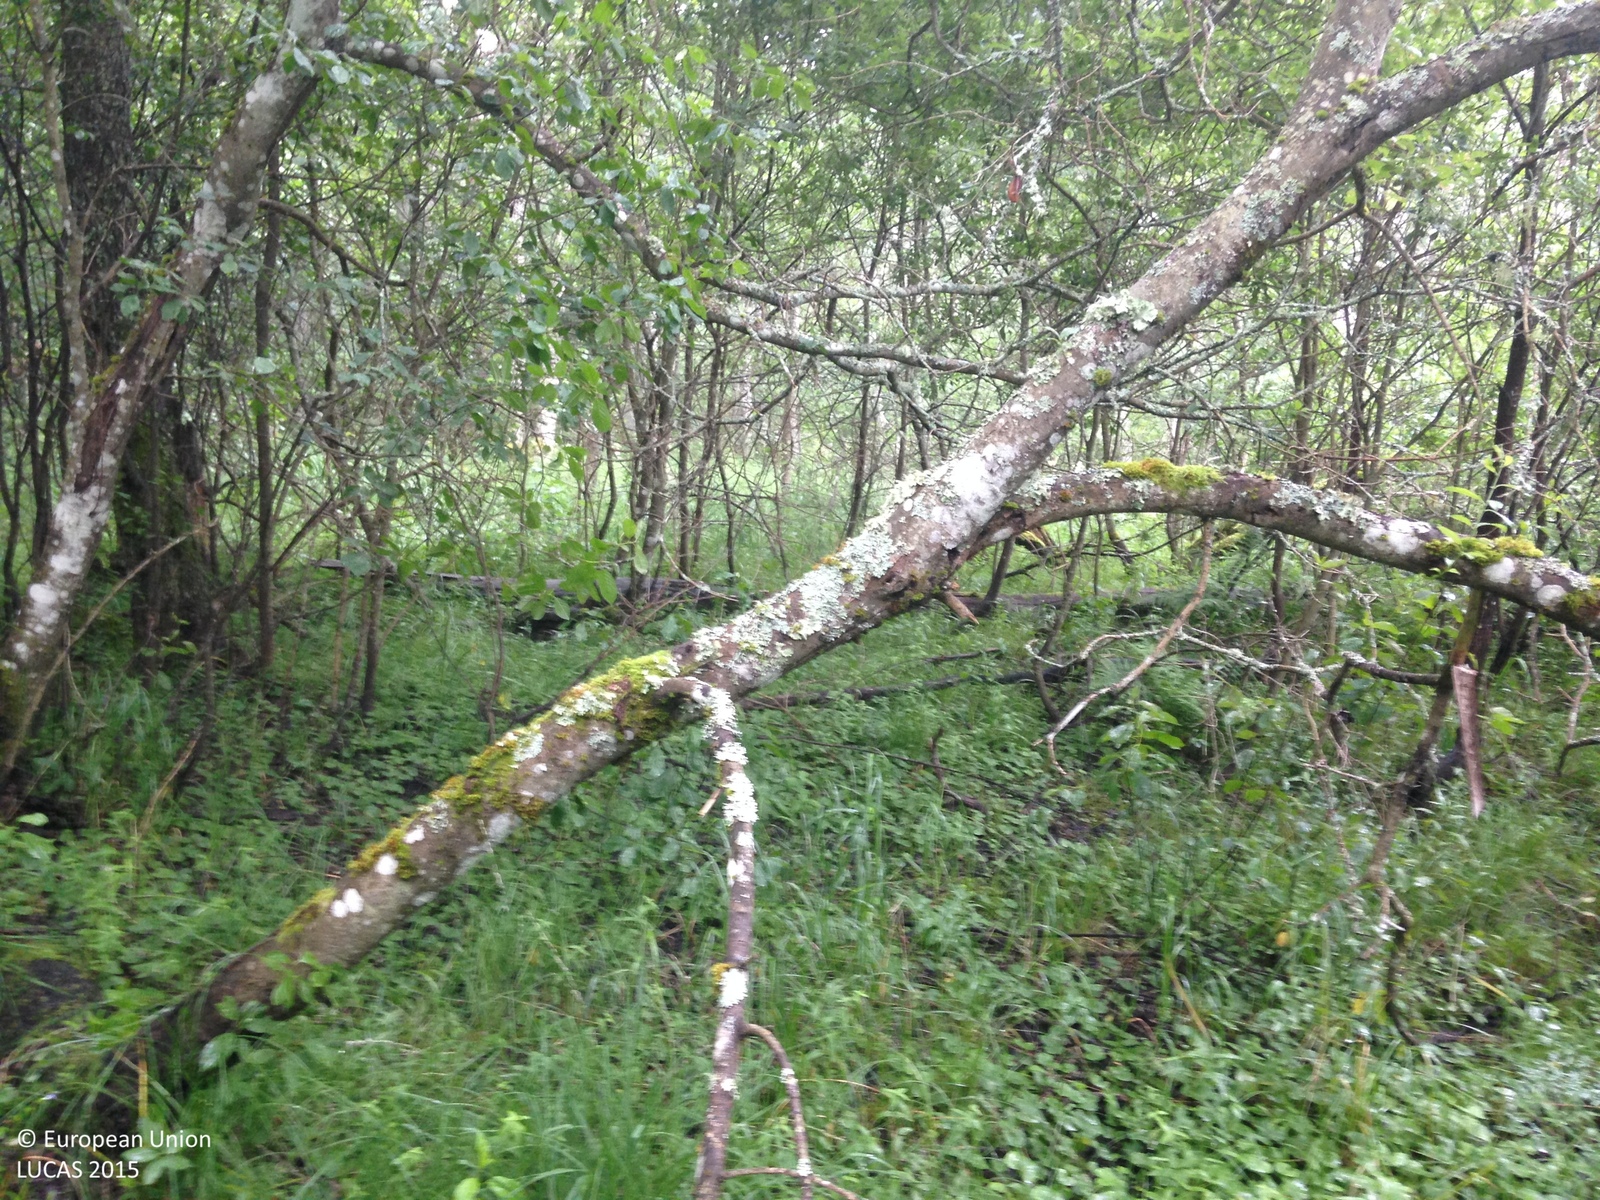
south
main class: Woodland
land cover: Broadleaved woodland
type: hemiboreal forest and nemoral coniferous forest and mixed broadleaved-coniferous forest
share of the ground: 25 - 50 %
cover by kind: herbaceous plants 55 %, broadleaved forest trees 45 %
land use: Forestry
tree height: > 5 m
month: July
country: SE
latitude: 59.1110
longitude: 14.6897
